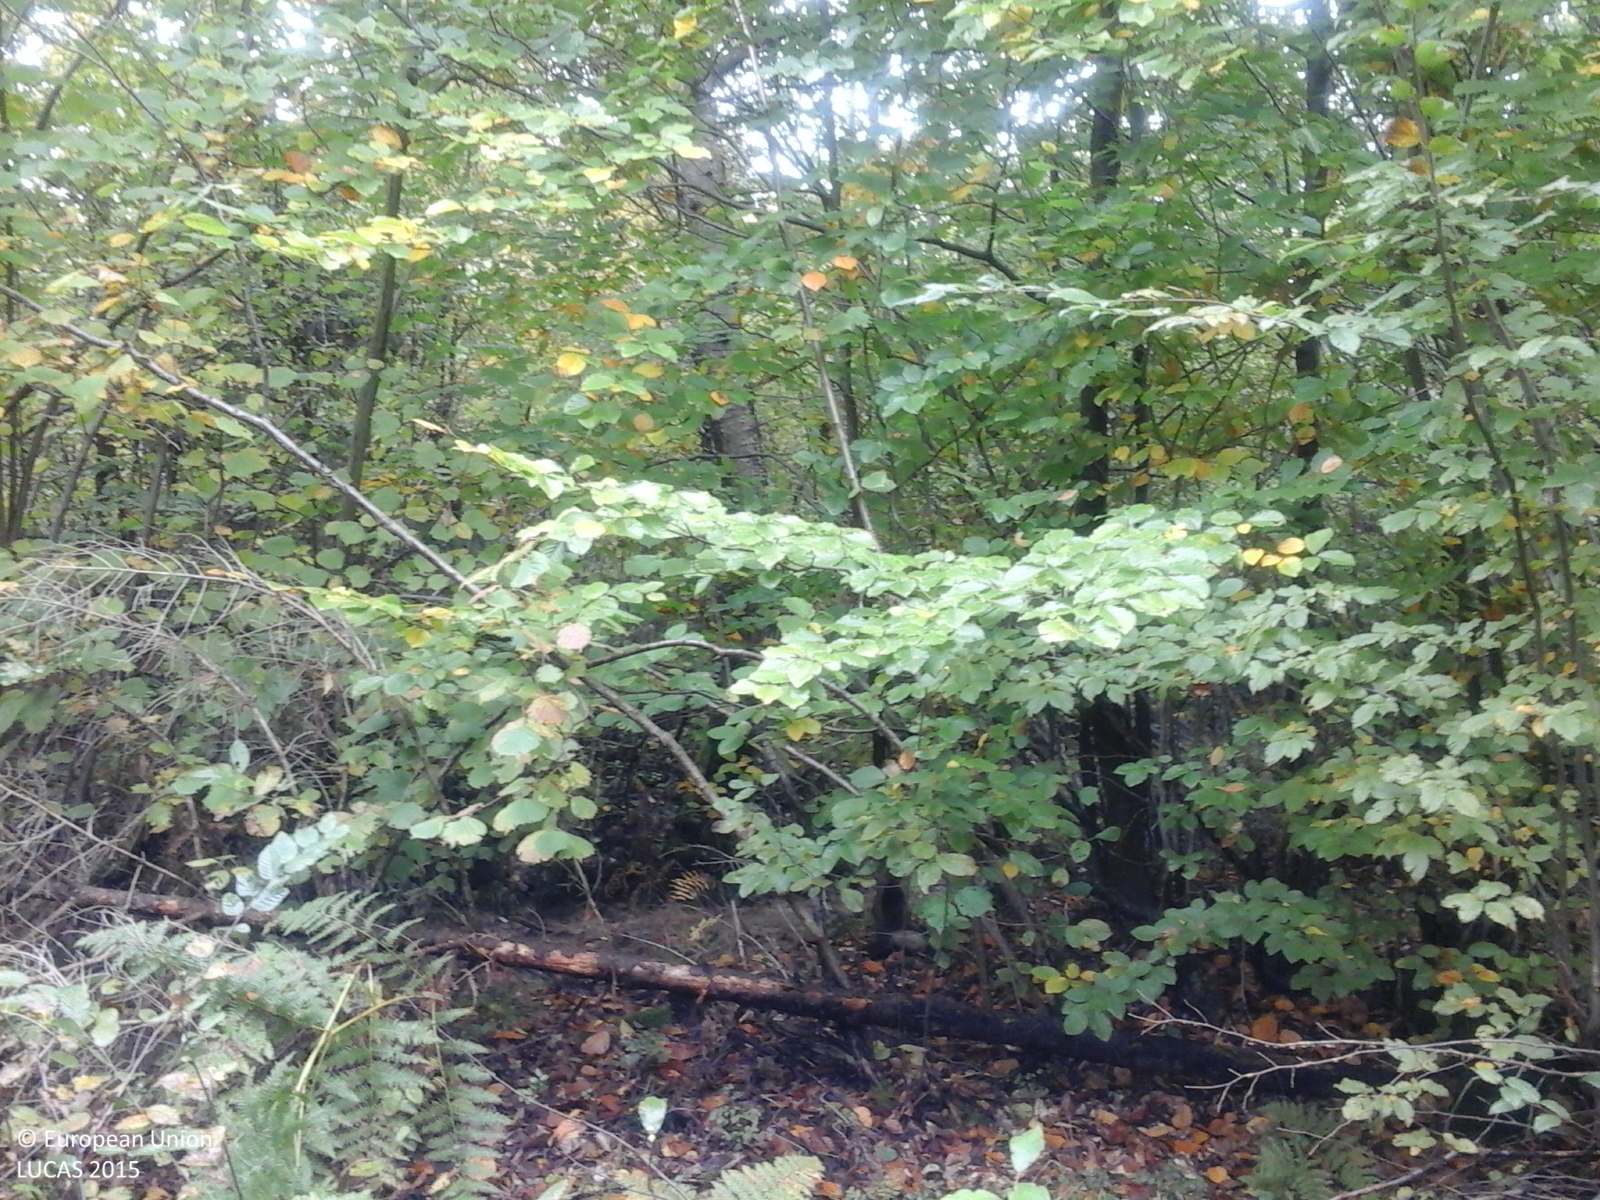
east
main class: Woodland
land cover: Broadleaved woodland
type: beech forest
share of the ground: > 75 %
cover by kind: broadleaved forest trees 100 %
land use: Forestry
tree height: > 5 m
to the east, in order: Broadleaved woodland; Tracks; Broadleaved woodland
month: October
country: RO
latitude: 45.7028
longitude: 25.0295
